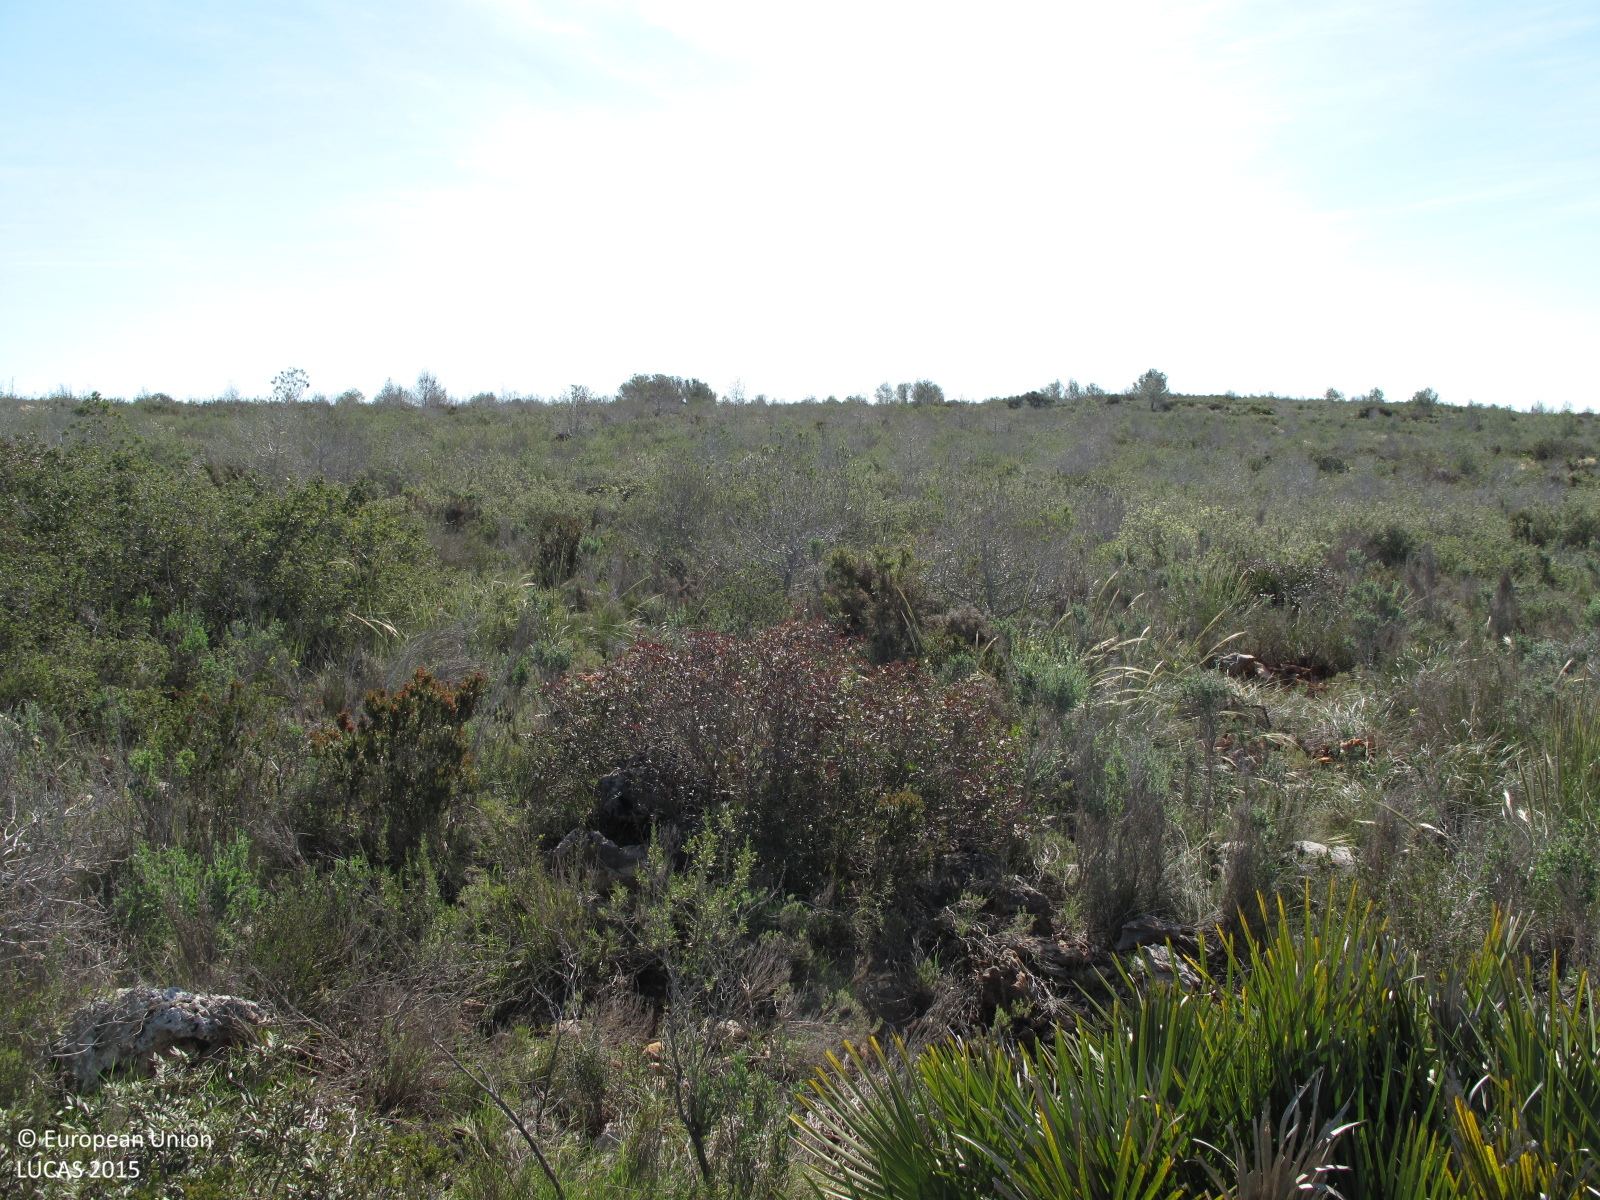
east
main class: Shrubland
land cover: Shrubland with sparse tree cover
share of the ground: > 75 %
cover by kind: shrubs 85 %, herbaceous plants 10 %, coniferous forest trees 5 %
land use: Semi-natural and natural areas not in use
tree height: < 5 m
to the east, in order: Shrubland with sparse tree cover; Grassland with sparse tree/shrub cover; Paved roads, cycling and walking lanes; Grassland with sparse tree/shrub cover; Shrubland with sparse tree cover
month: March
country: ES
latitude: 39.1412
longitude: -0.6274
